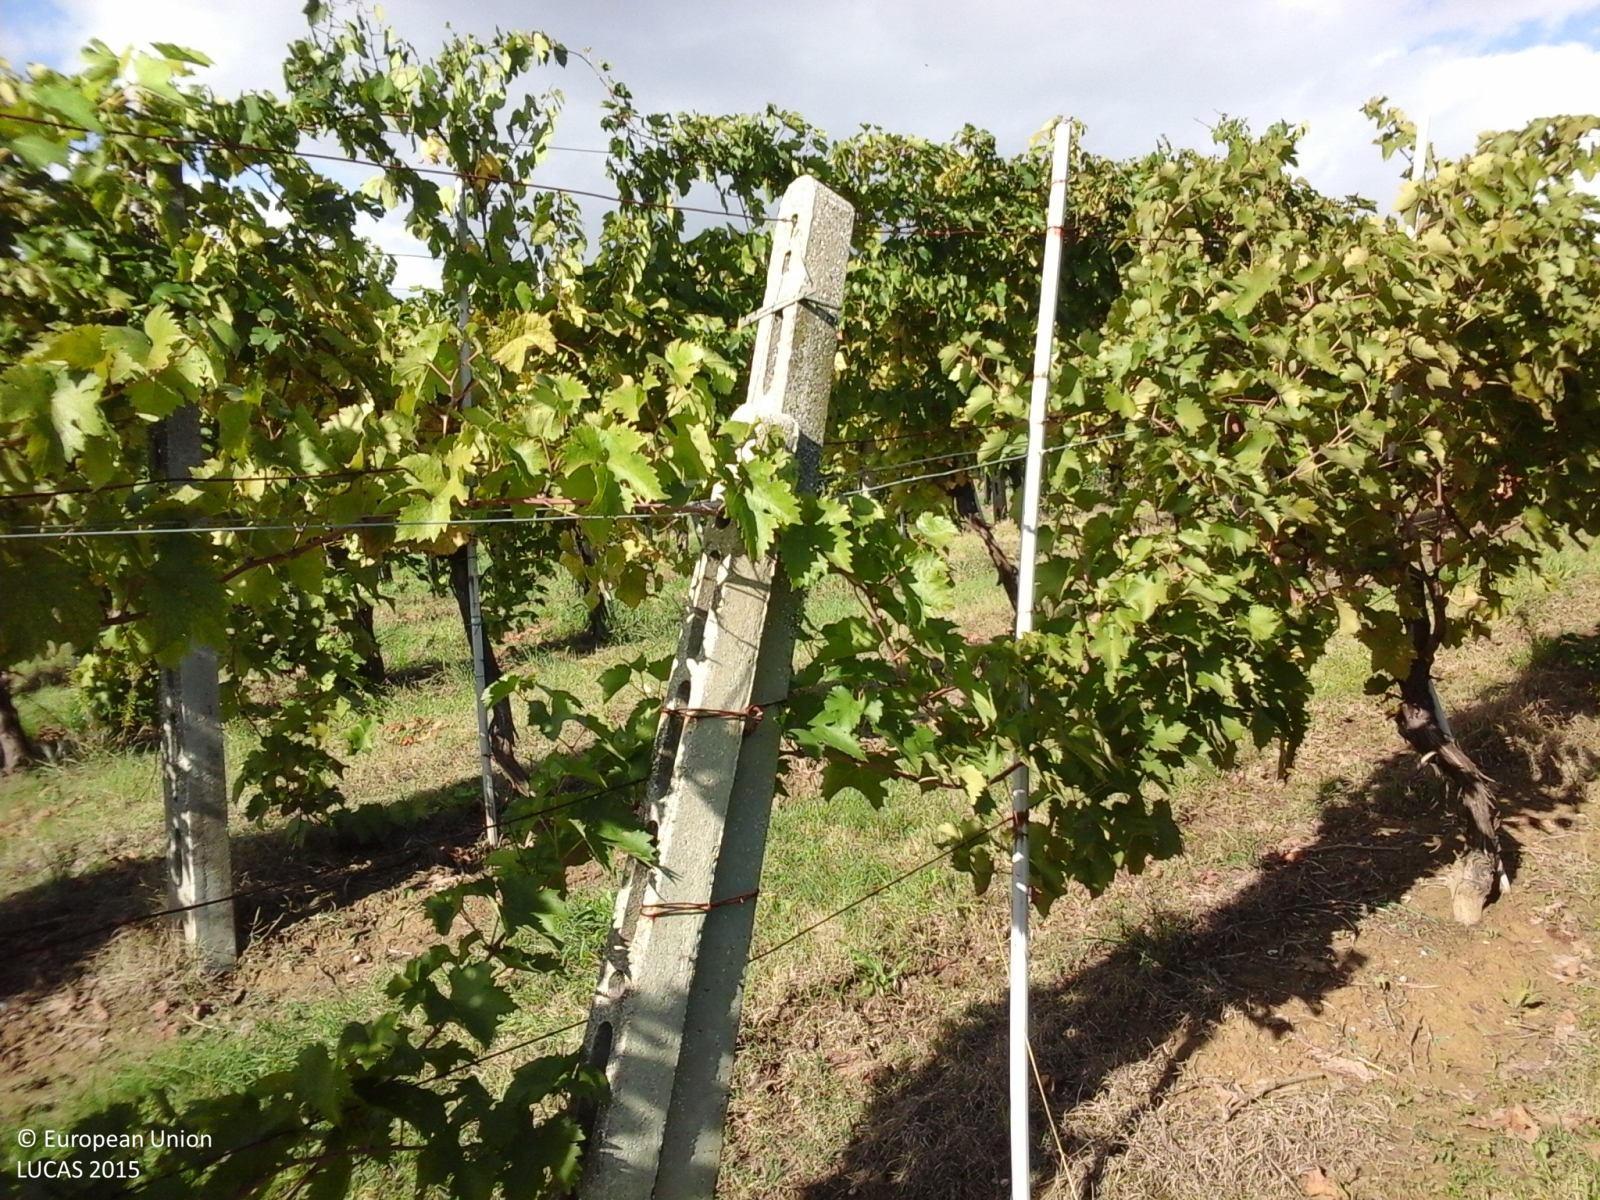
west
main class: Cropland
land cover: Vineyards
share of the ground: 50 - 75 %
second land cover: Grassland without tree/shrub cover
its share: > 75 %
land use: Agriculture (excluding fallow land and kitchen gardens)
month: October
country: IT
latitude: 43.6692
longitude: 13.2045
